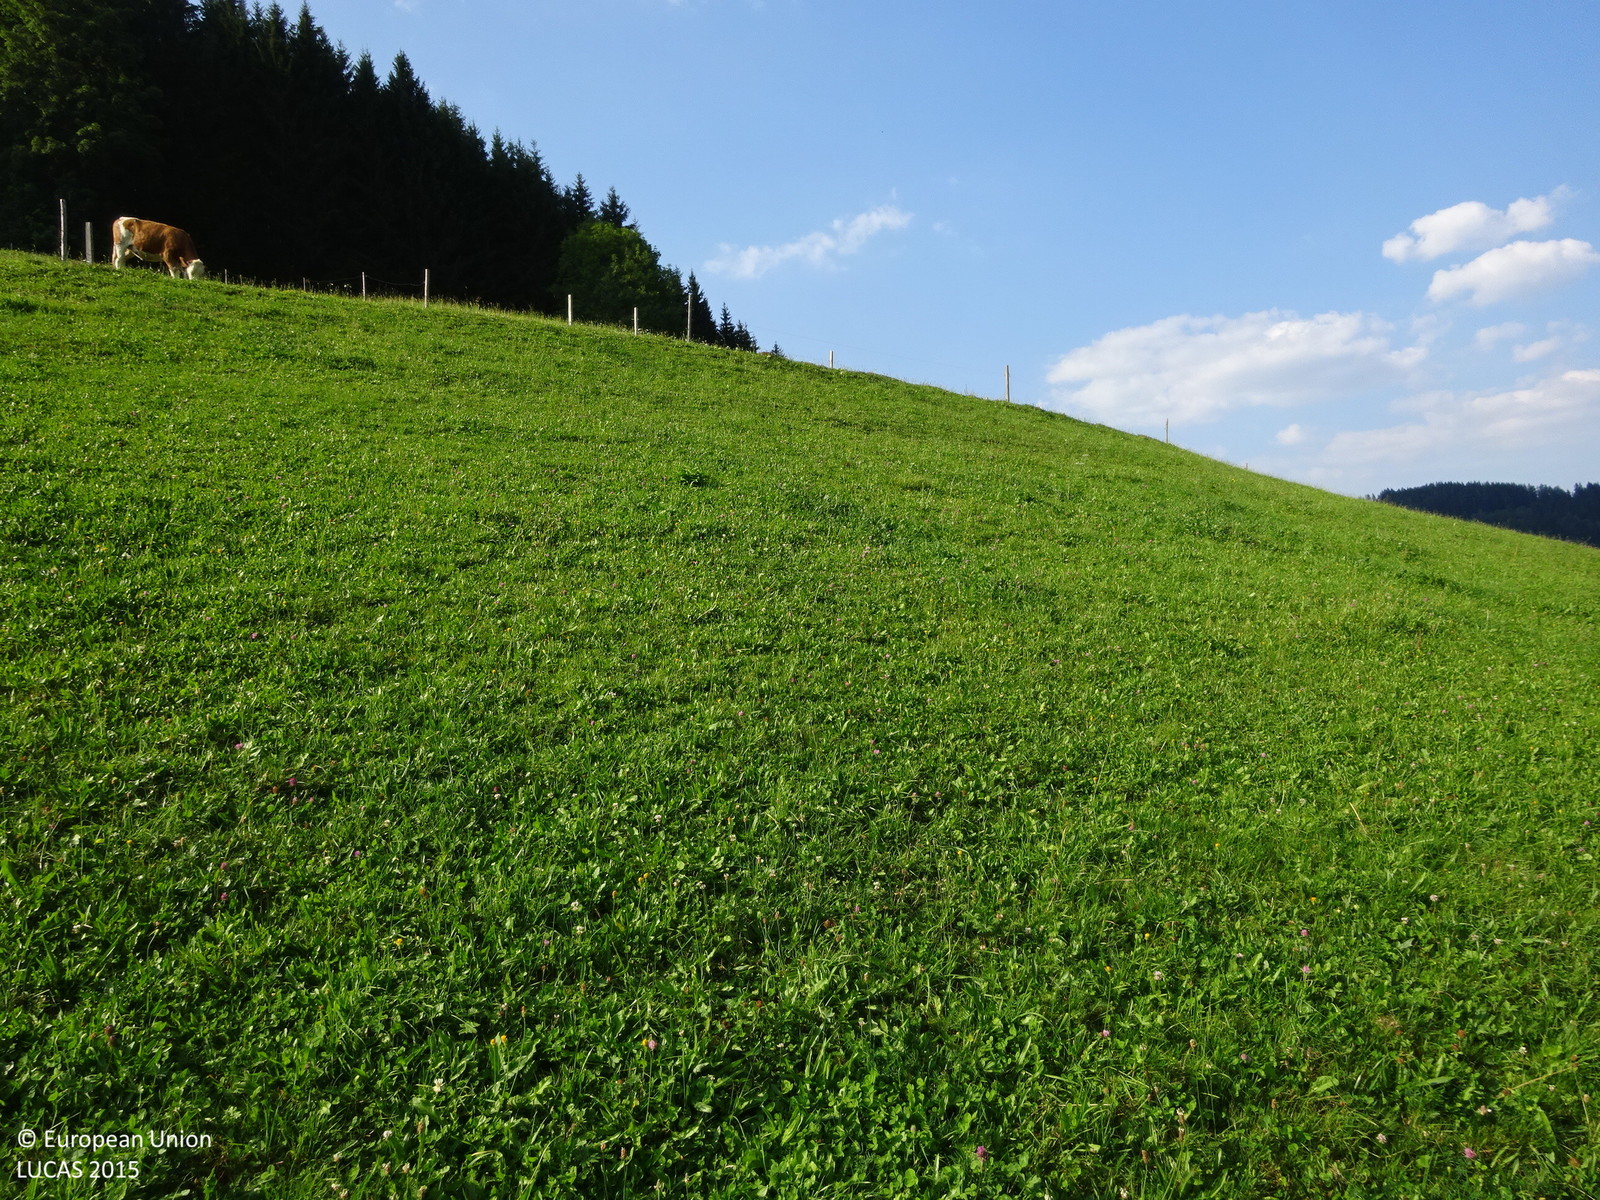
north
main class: Grassland
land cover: Grassland without tree/shrub cover
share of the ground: > 75 %
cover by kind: herbaceous plants 100 %
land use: Agriculture (excluding fallow land and kitchen gardens)
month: August
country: AT
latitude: 47.4962
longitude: 15.7493
